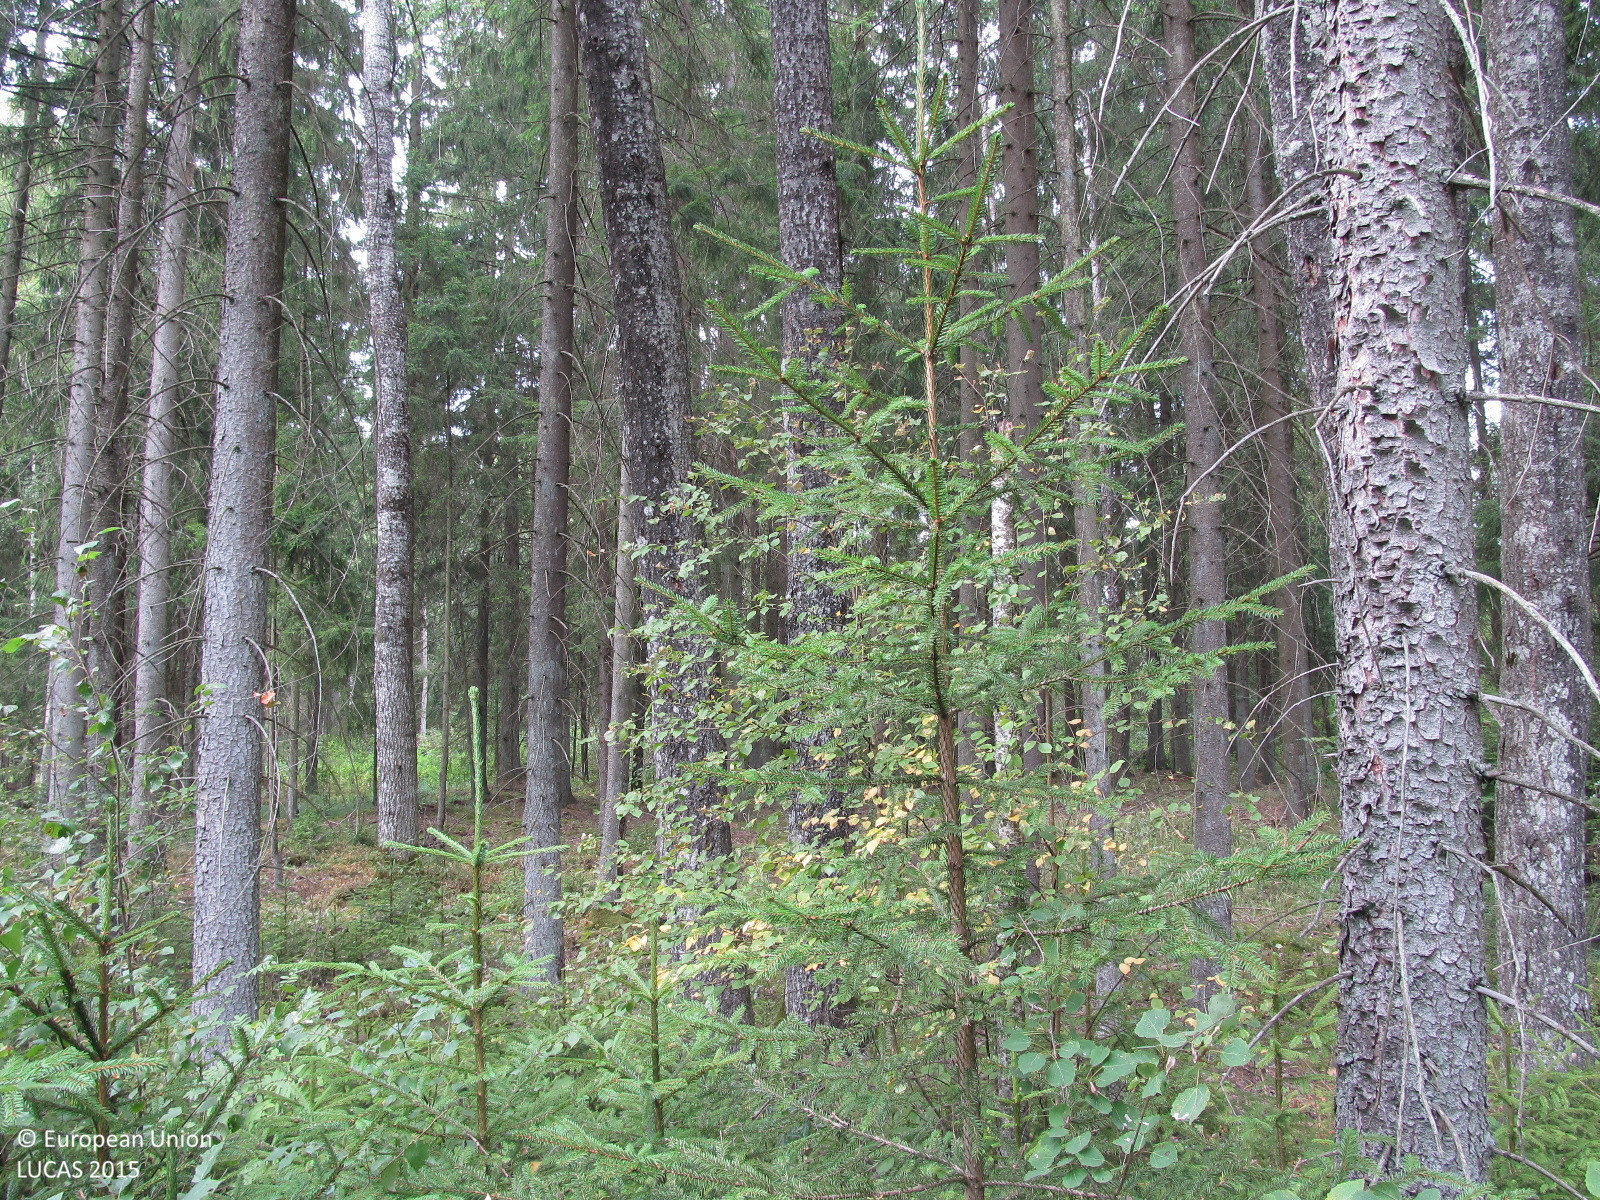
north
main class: Woodland
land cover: Spruce dominated mixed woodland
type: hemiboreal forest and nemoral coniferous forest and mixed broadleaved-coniferous forest
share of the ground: > 75 %
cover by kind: coniferous forest trees 50 %, broadleaved forest trees 30 %, shrubs 10 %, herbaceous plants 5 %, lichens and mosses 5 %
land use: Forestry
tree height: > 5 m
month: August
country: LT
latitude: 55.6516
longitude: 22.9890
